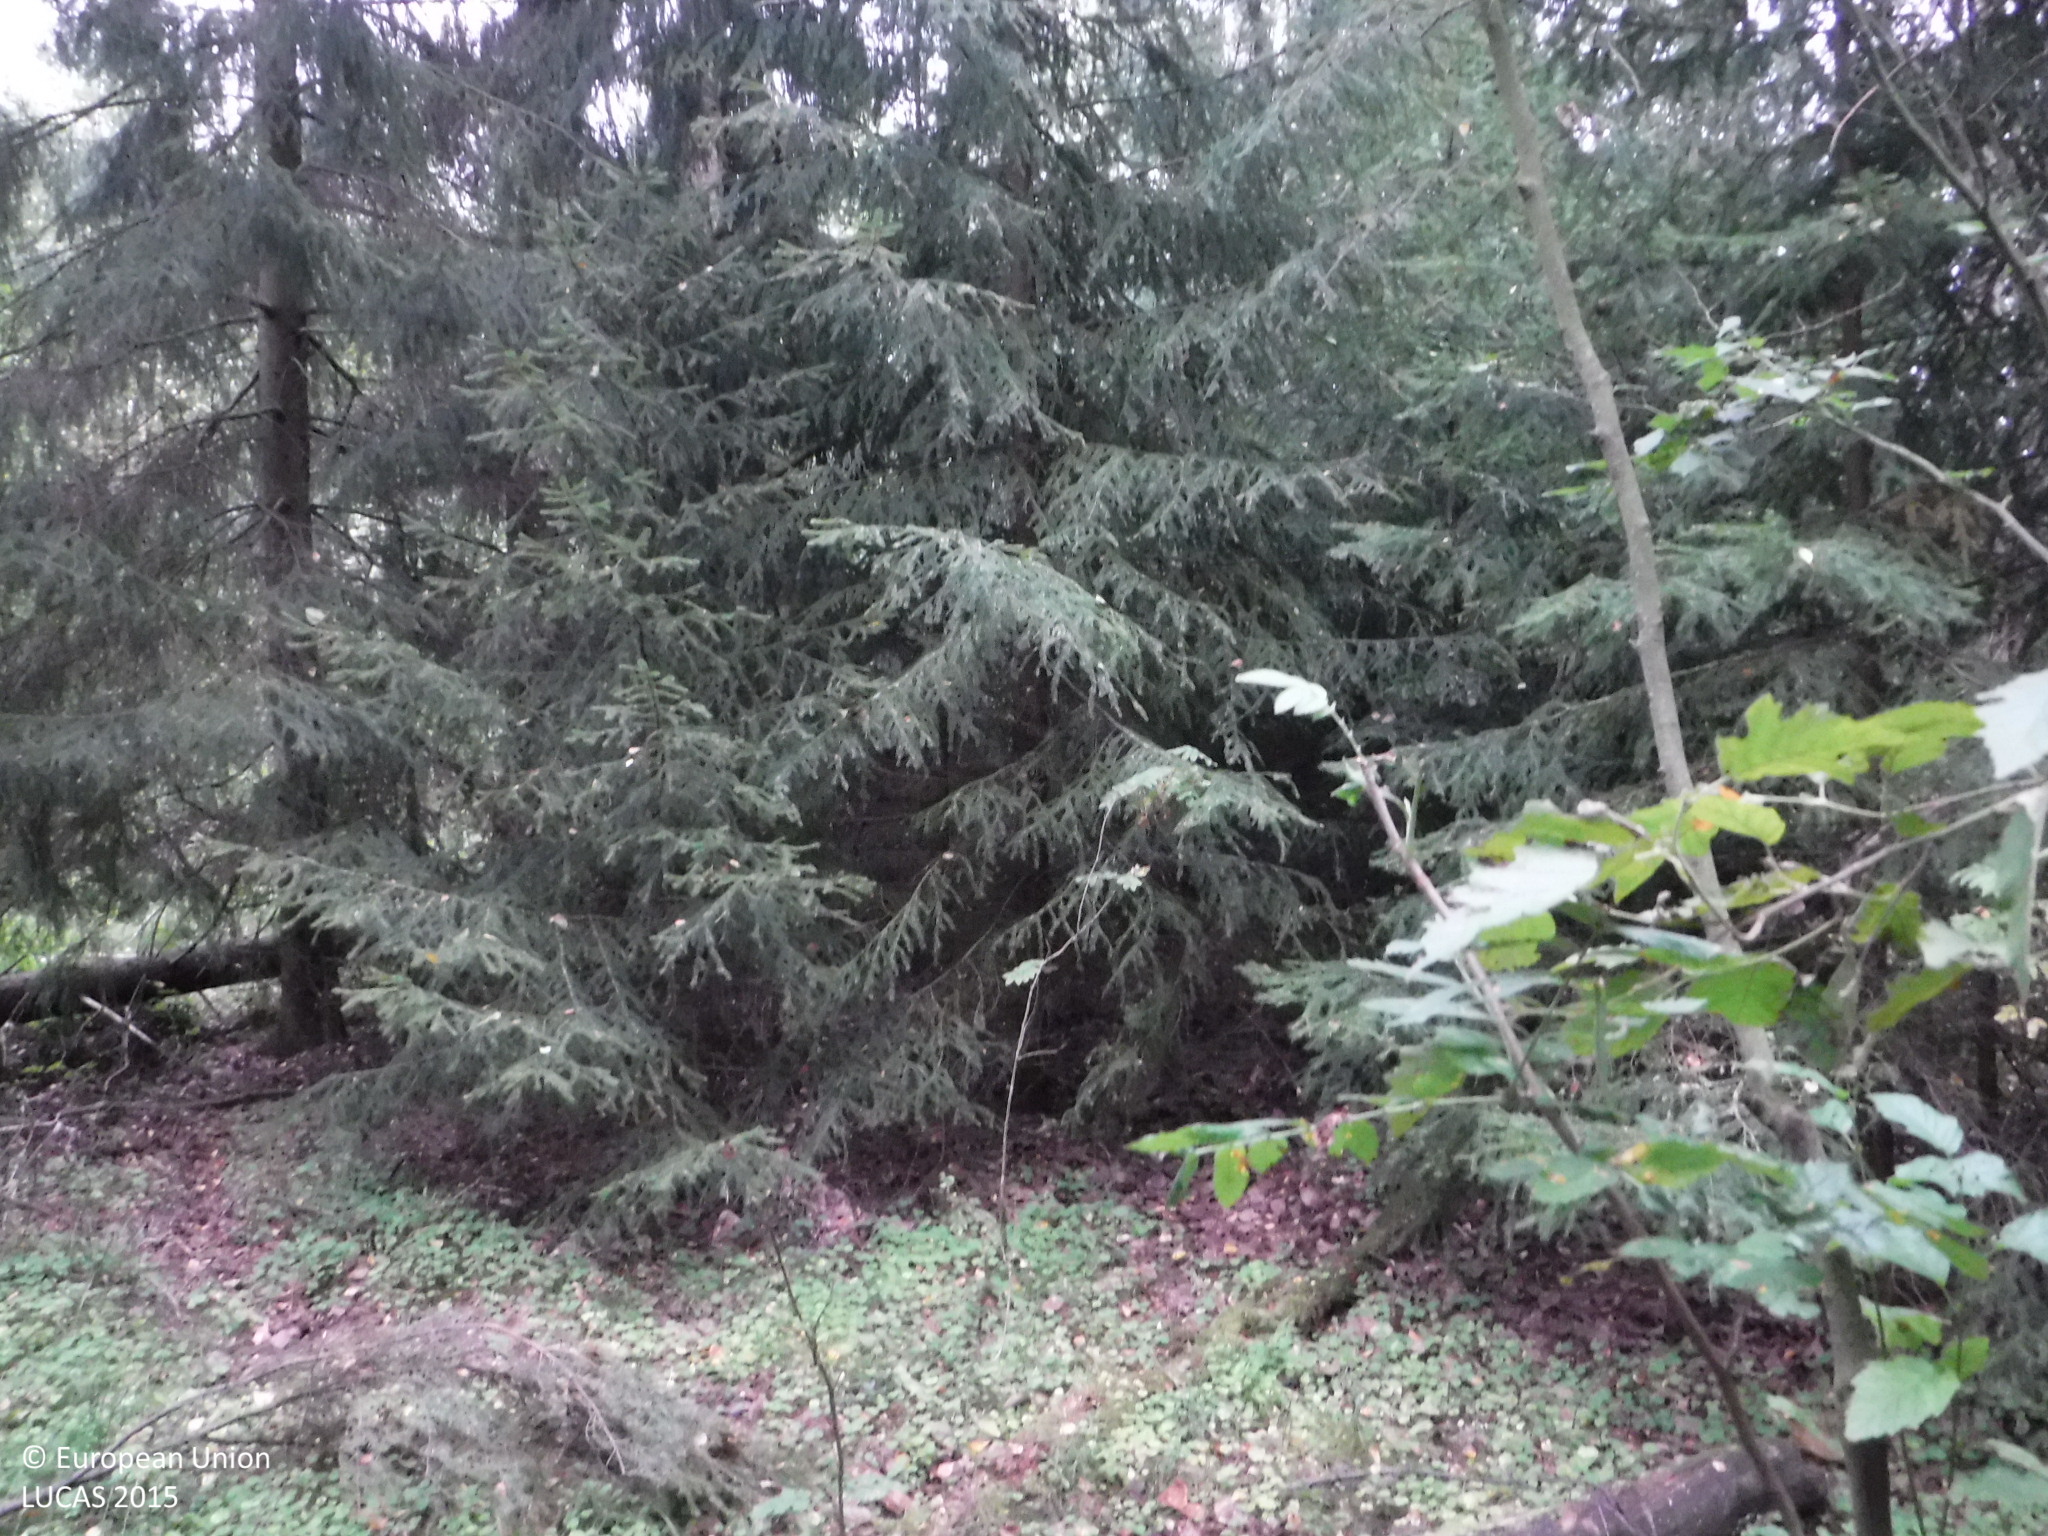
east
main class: Woodland
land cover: Other mixed woodland
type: boreal forest
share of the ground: > 75 %
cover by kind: broadleaved forest trees 40 %, coniferous forest trees 35 %, herbaceous plants 10 %, unconsolidated bare surface 10 %, shrubs 5 %
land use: Semi-natural and natural areas not in use
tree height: > 5 m
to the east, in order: Other mixed woodland; Barley; Grass margins; Ditches and canals; Grass margins; Other root crops
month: September
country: FI
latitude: 61.3418
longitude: 22.0397
